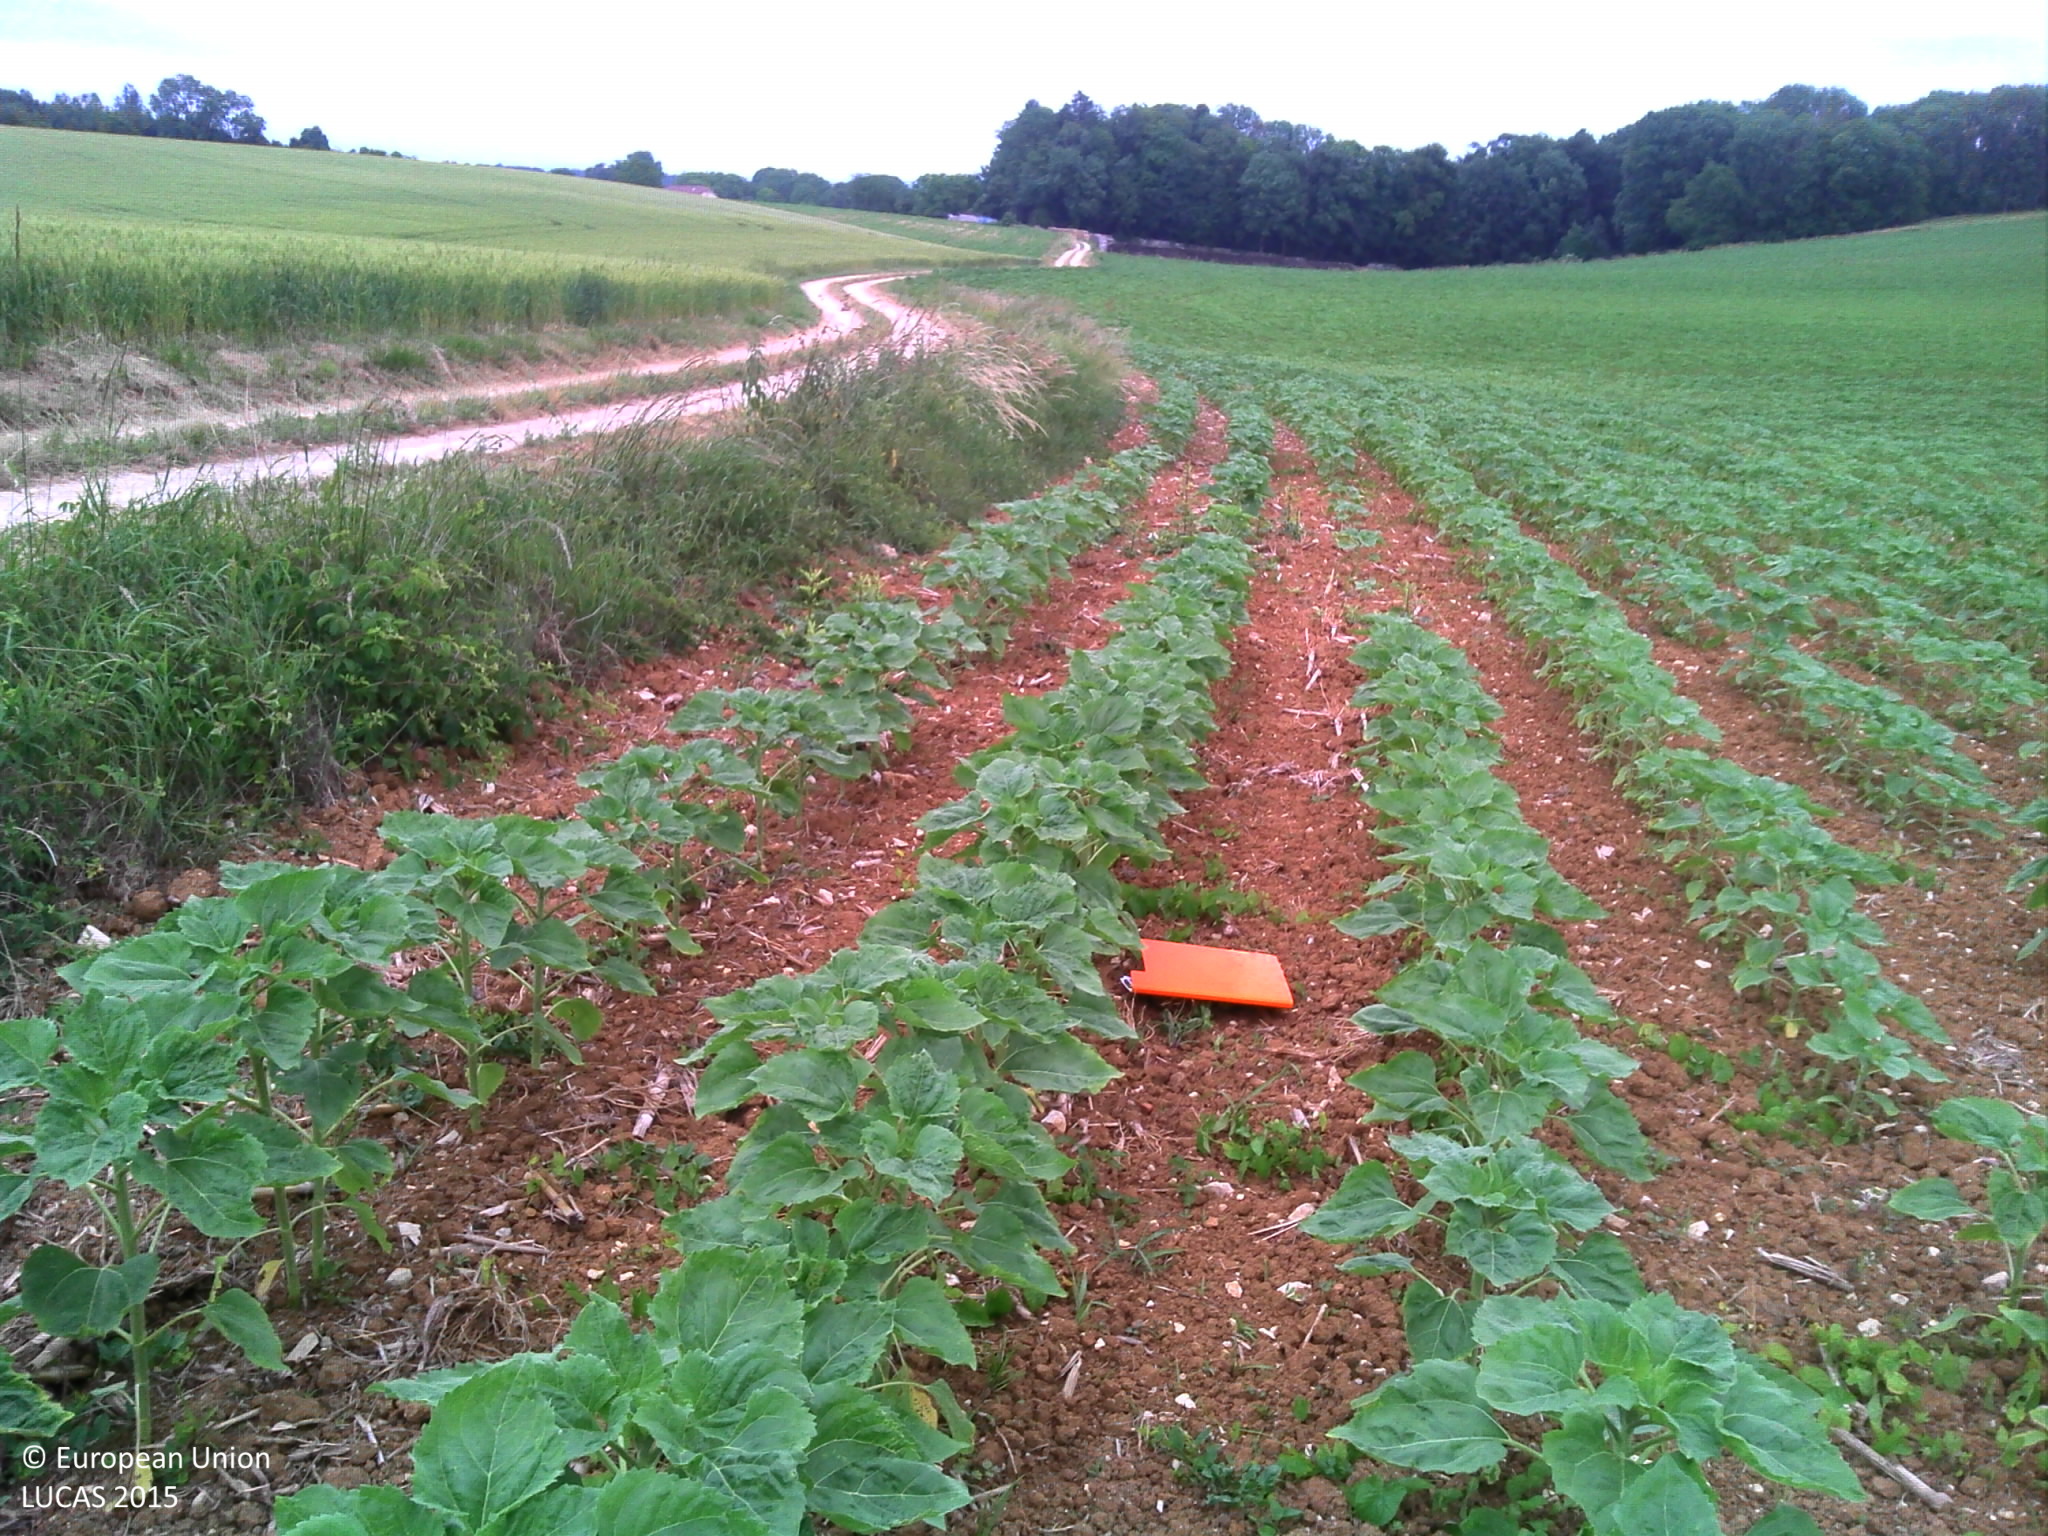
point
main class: Cropland
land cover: Common wheat
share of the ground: > 75 %
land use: Agriculture (excluding fallow land and kitchen gardens)
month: June
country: FR
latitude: 47.5137
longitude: 6.3233
